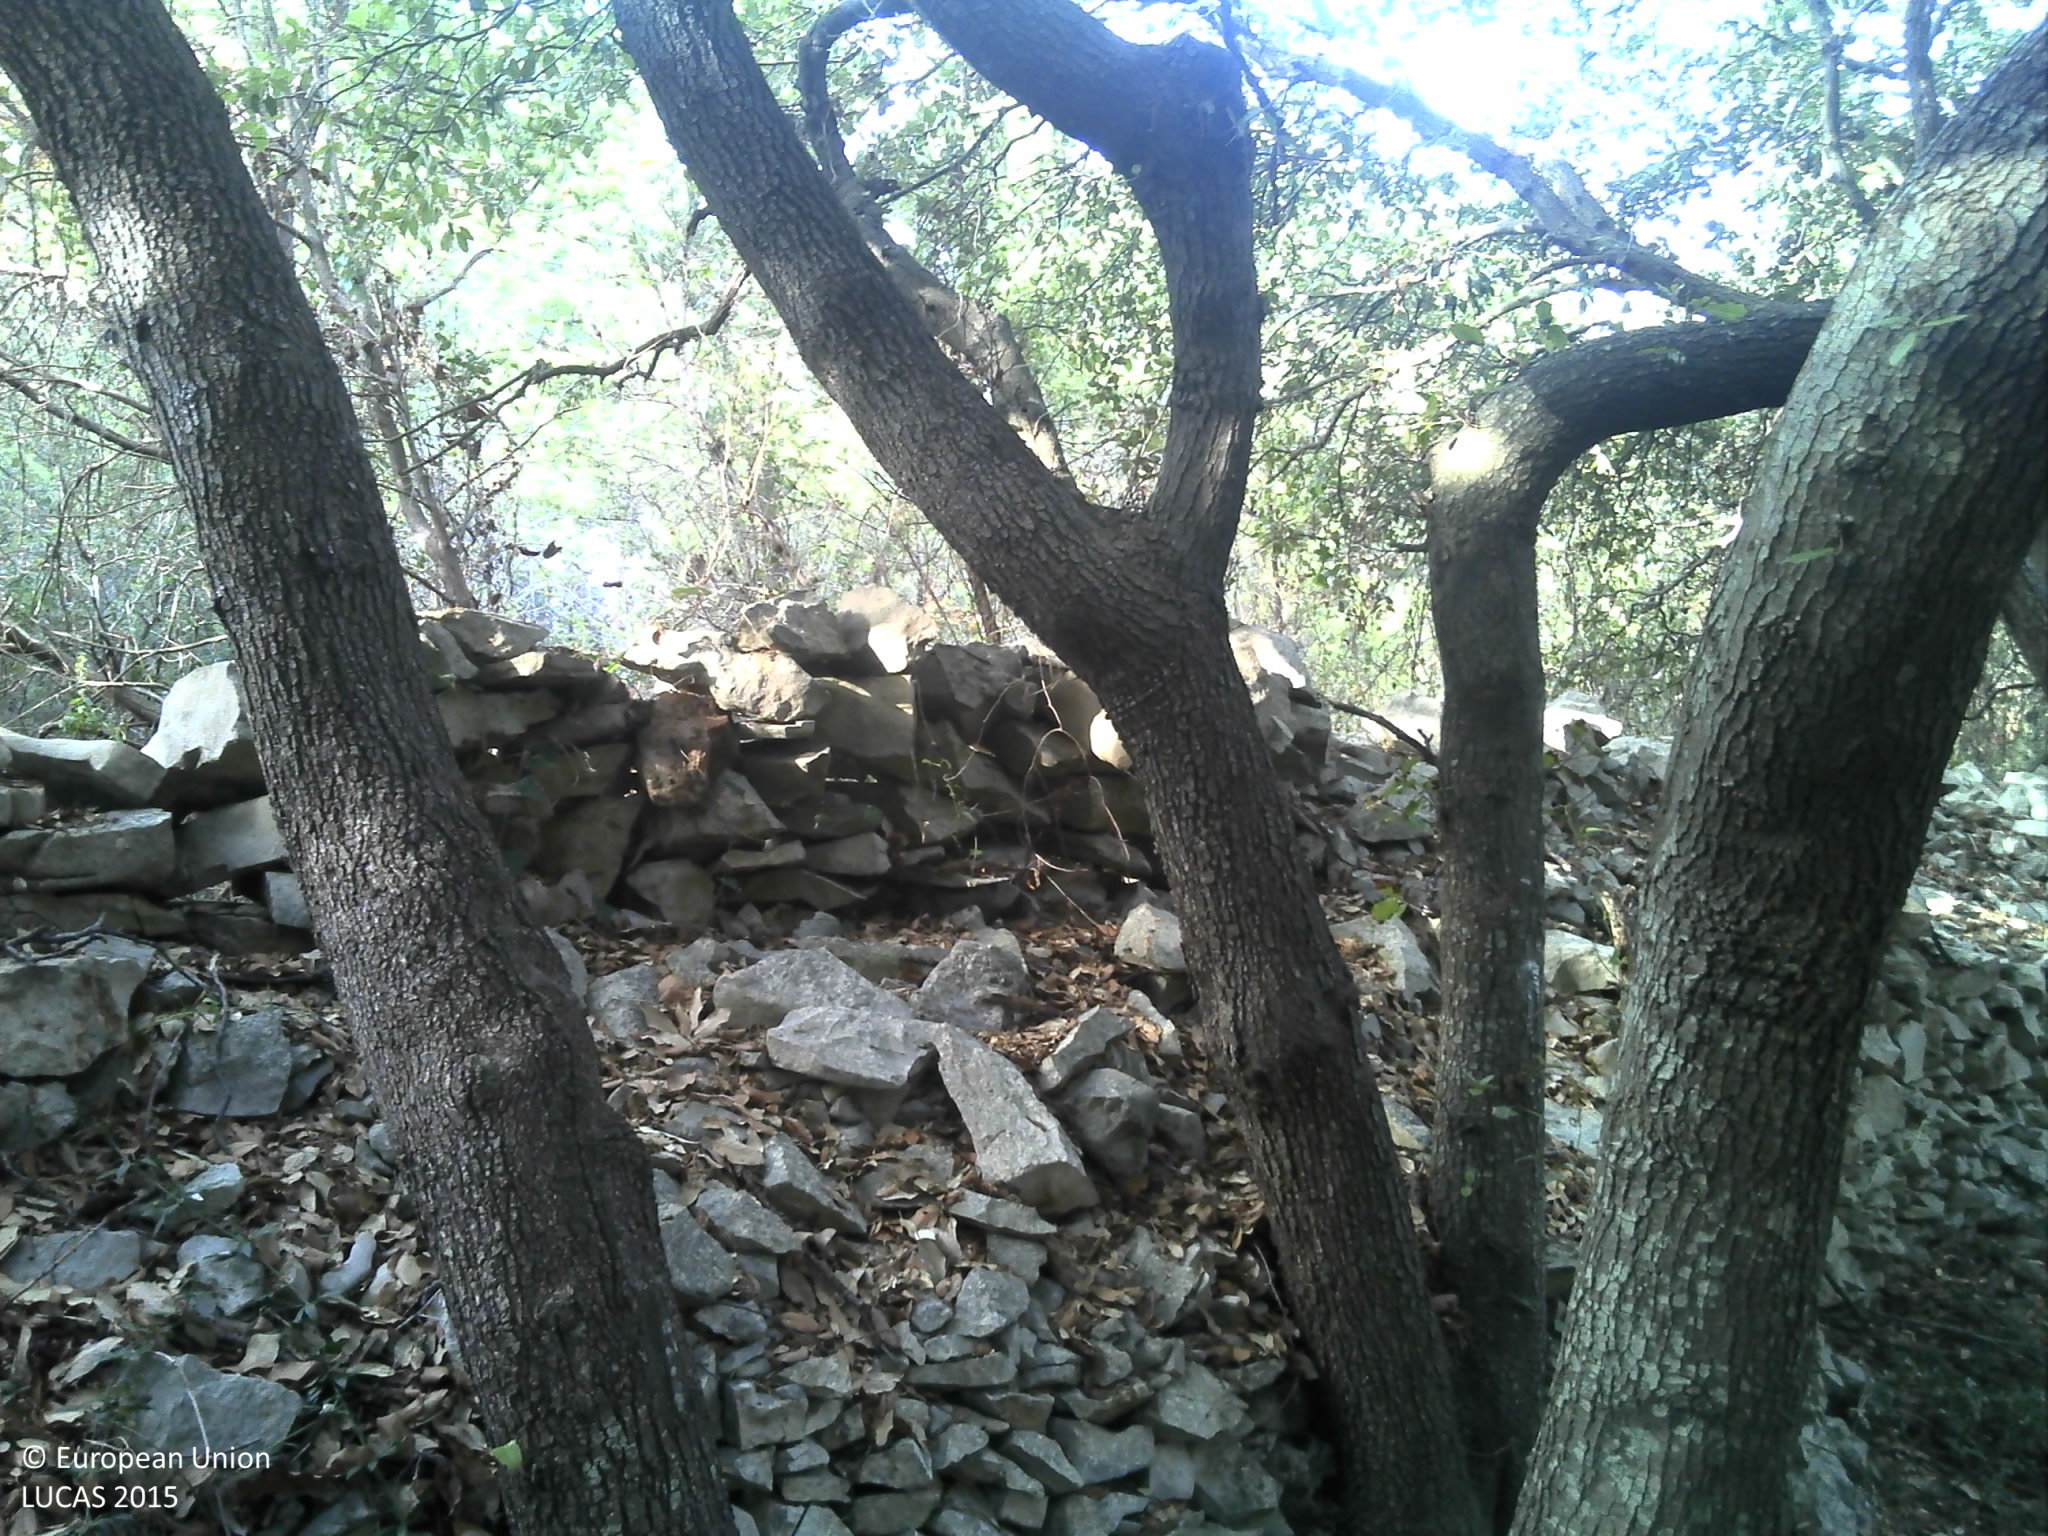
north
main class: Woodland
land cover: Pine dominated coniferous woodland
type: coniferous forest of the mediterranean region
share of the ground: > 75 %
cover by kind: coniferous forest trees 70 %, shrubs 10 %, herbaceous plants 10 %, broadleaved forest trees 5 %, consolidated bare surface 5 %
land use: Abandoned areas
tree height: > 5 m
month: September
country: HR
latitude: 44.1466
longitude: 14.8552
